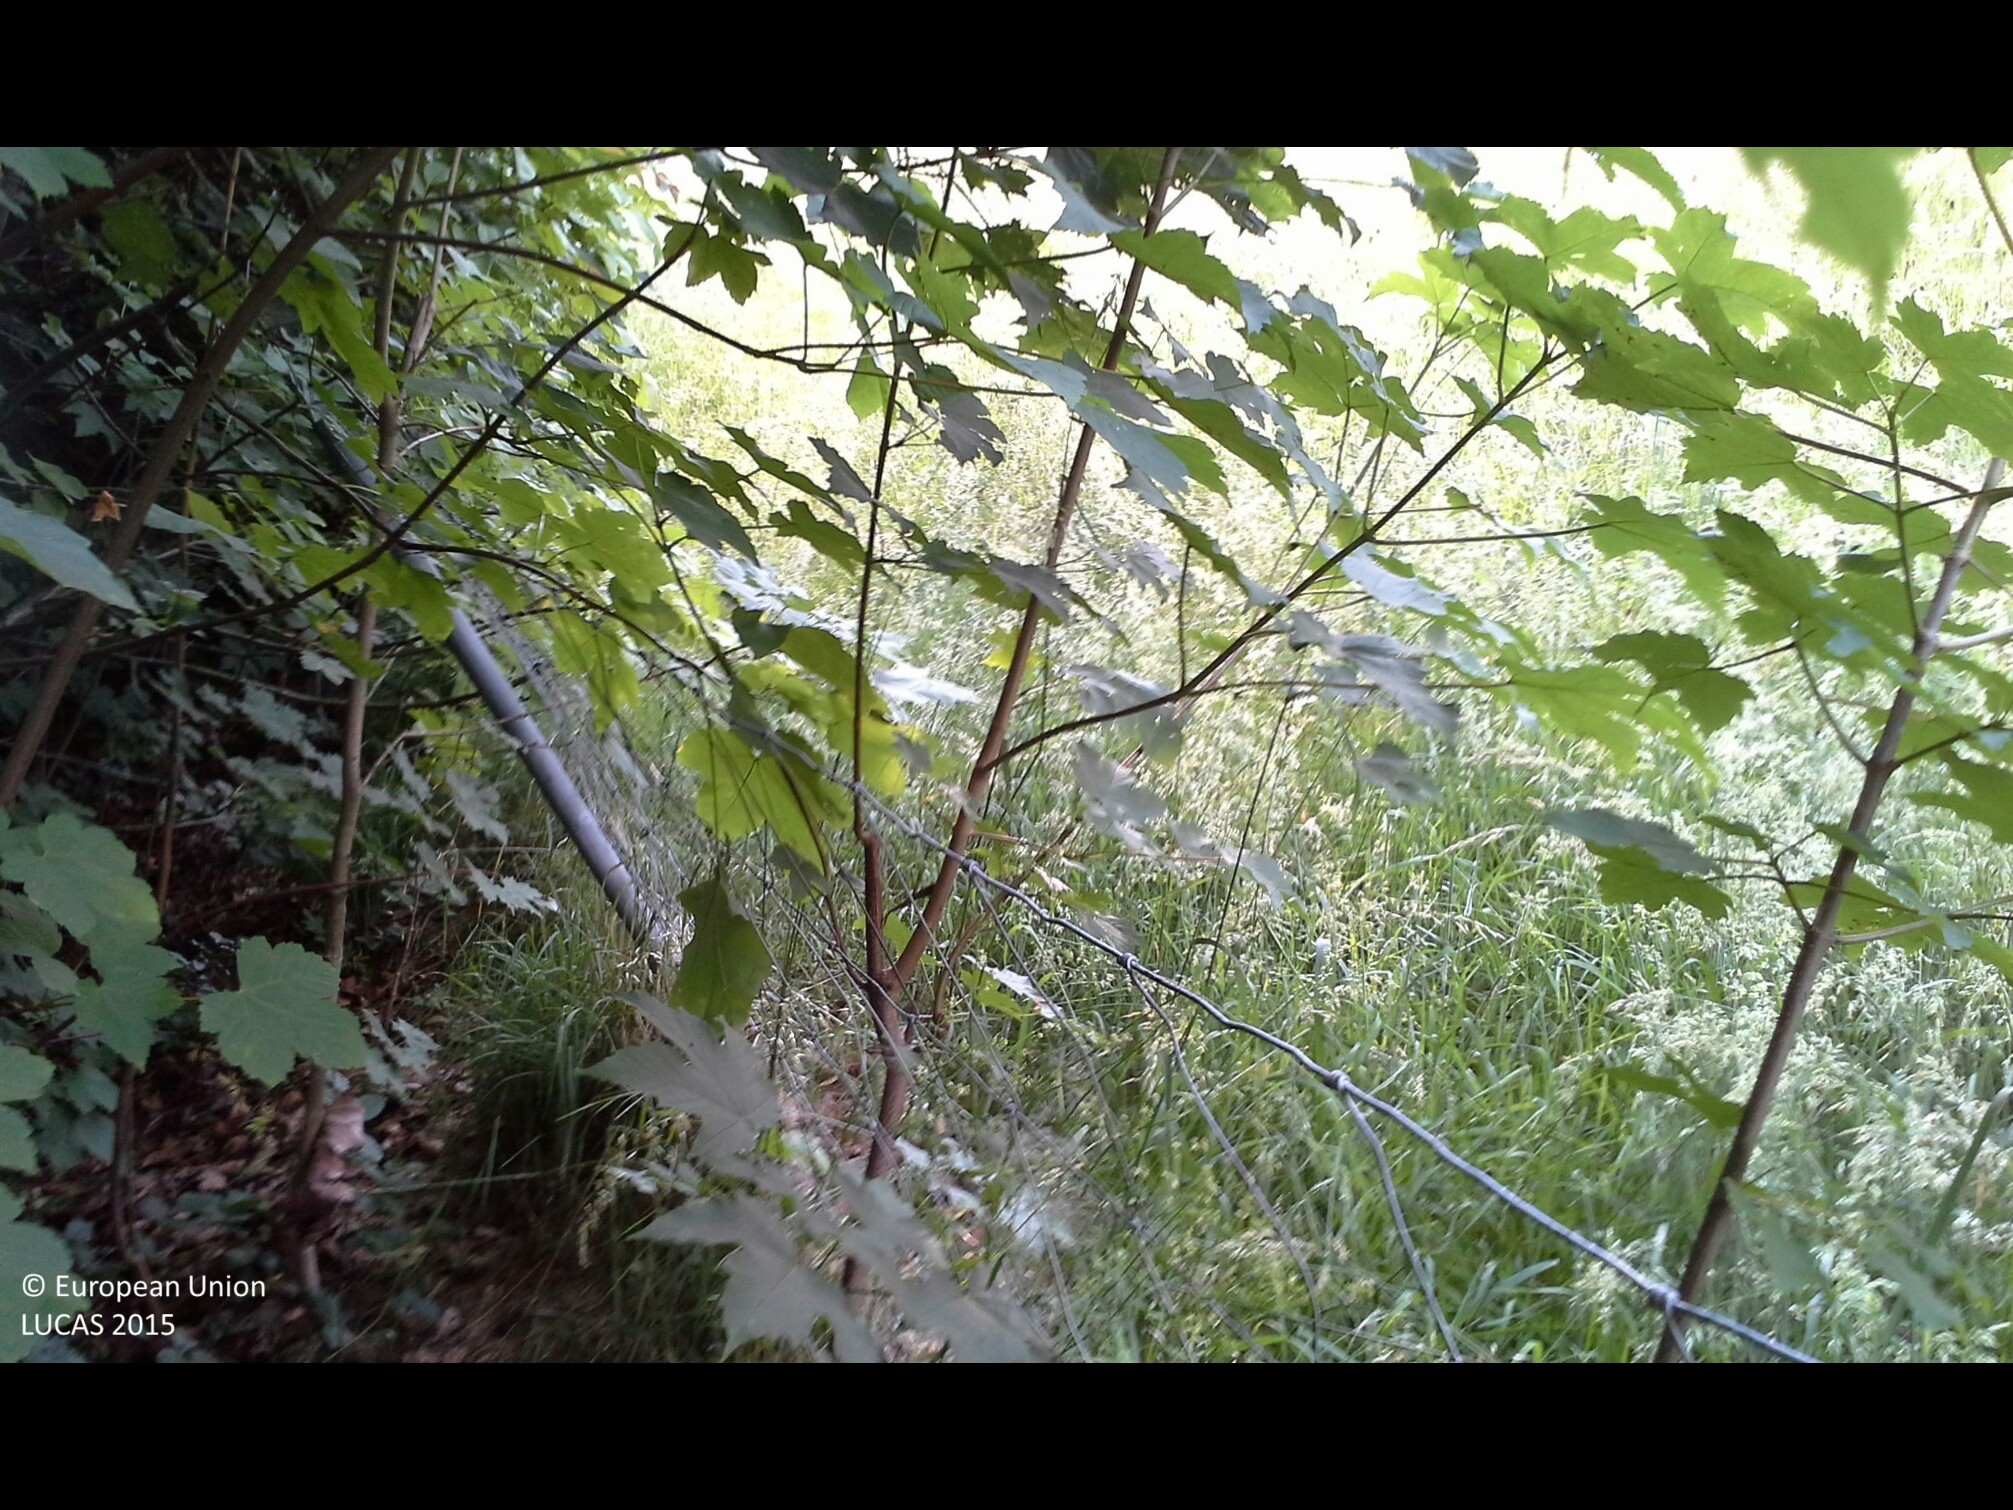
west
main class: Grassland
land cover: Grassland with sparse tree/shrub cover
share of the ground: > 75 %
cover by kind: herbaceous plants 95 %, broadleaved forest trees 5 %
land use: Agriculture (excluding fallow land and kitchen gardens)
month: June
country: AT
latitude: 47.8713
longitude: 13.7559
